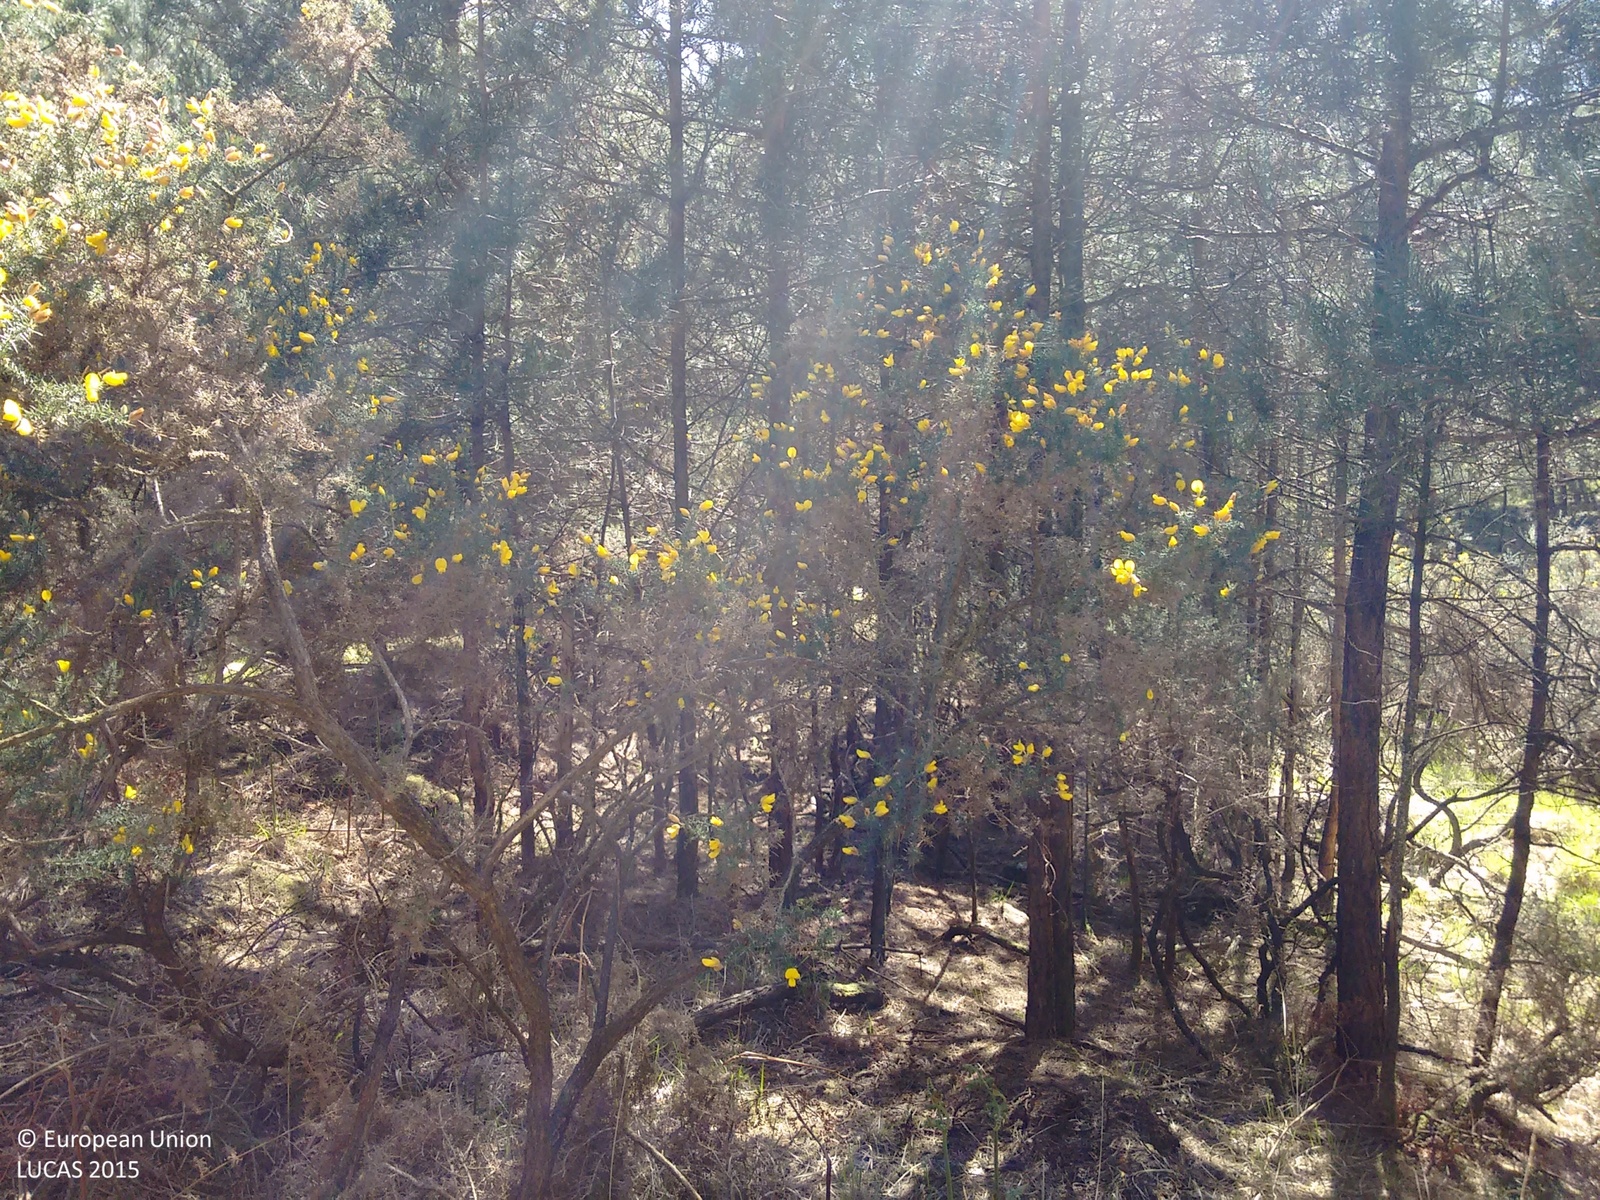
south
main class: Woodland
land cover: Pine dominated mixed woodland
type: hemiboreal forest and nemoral coniferous forest and mixed broadleaved-coniferous forest
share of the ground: > 75 %
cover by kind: coniferous forest trees 70 %, broadleaved forest trees 25 %, shrubs 5 %
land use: Forestry
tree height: > 5 m
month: May
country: GB
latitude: 50.6469
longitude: -2.0947
